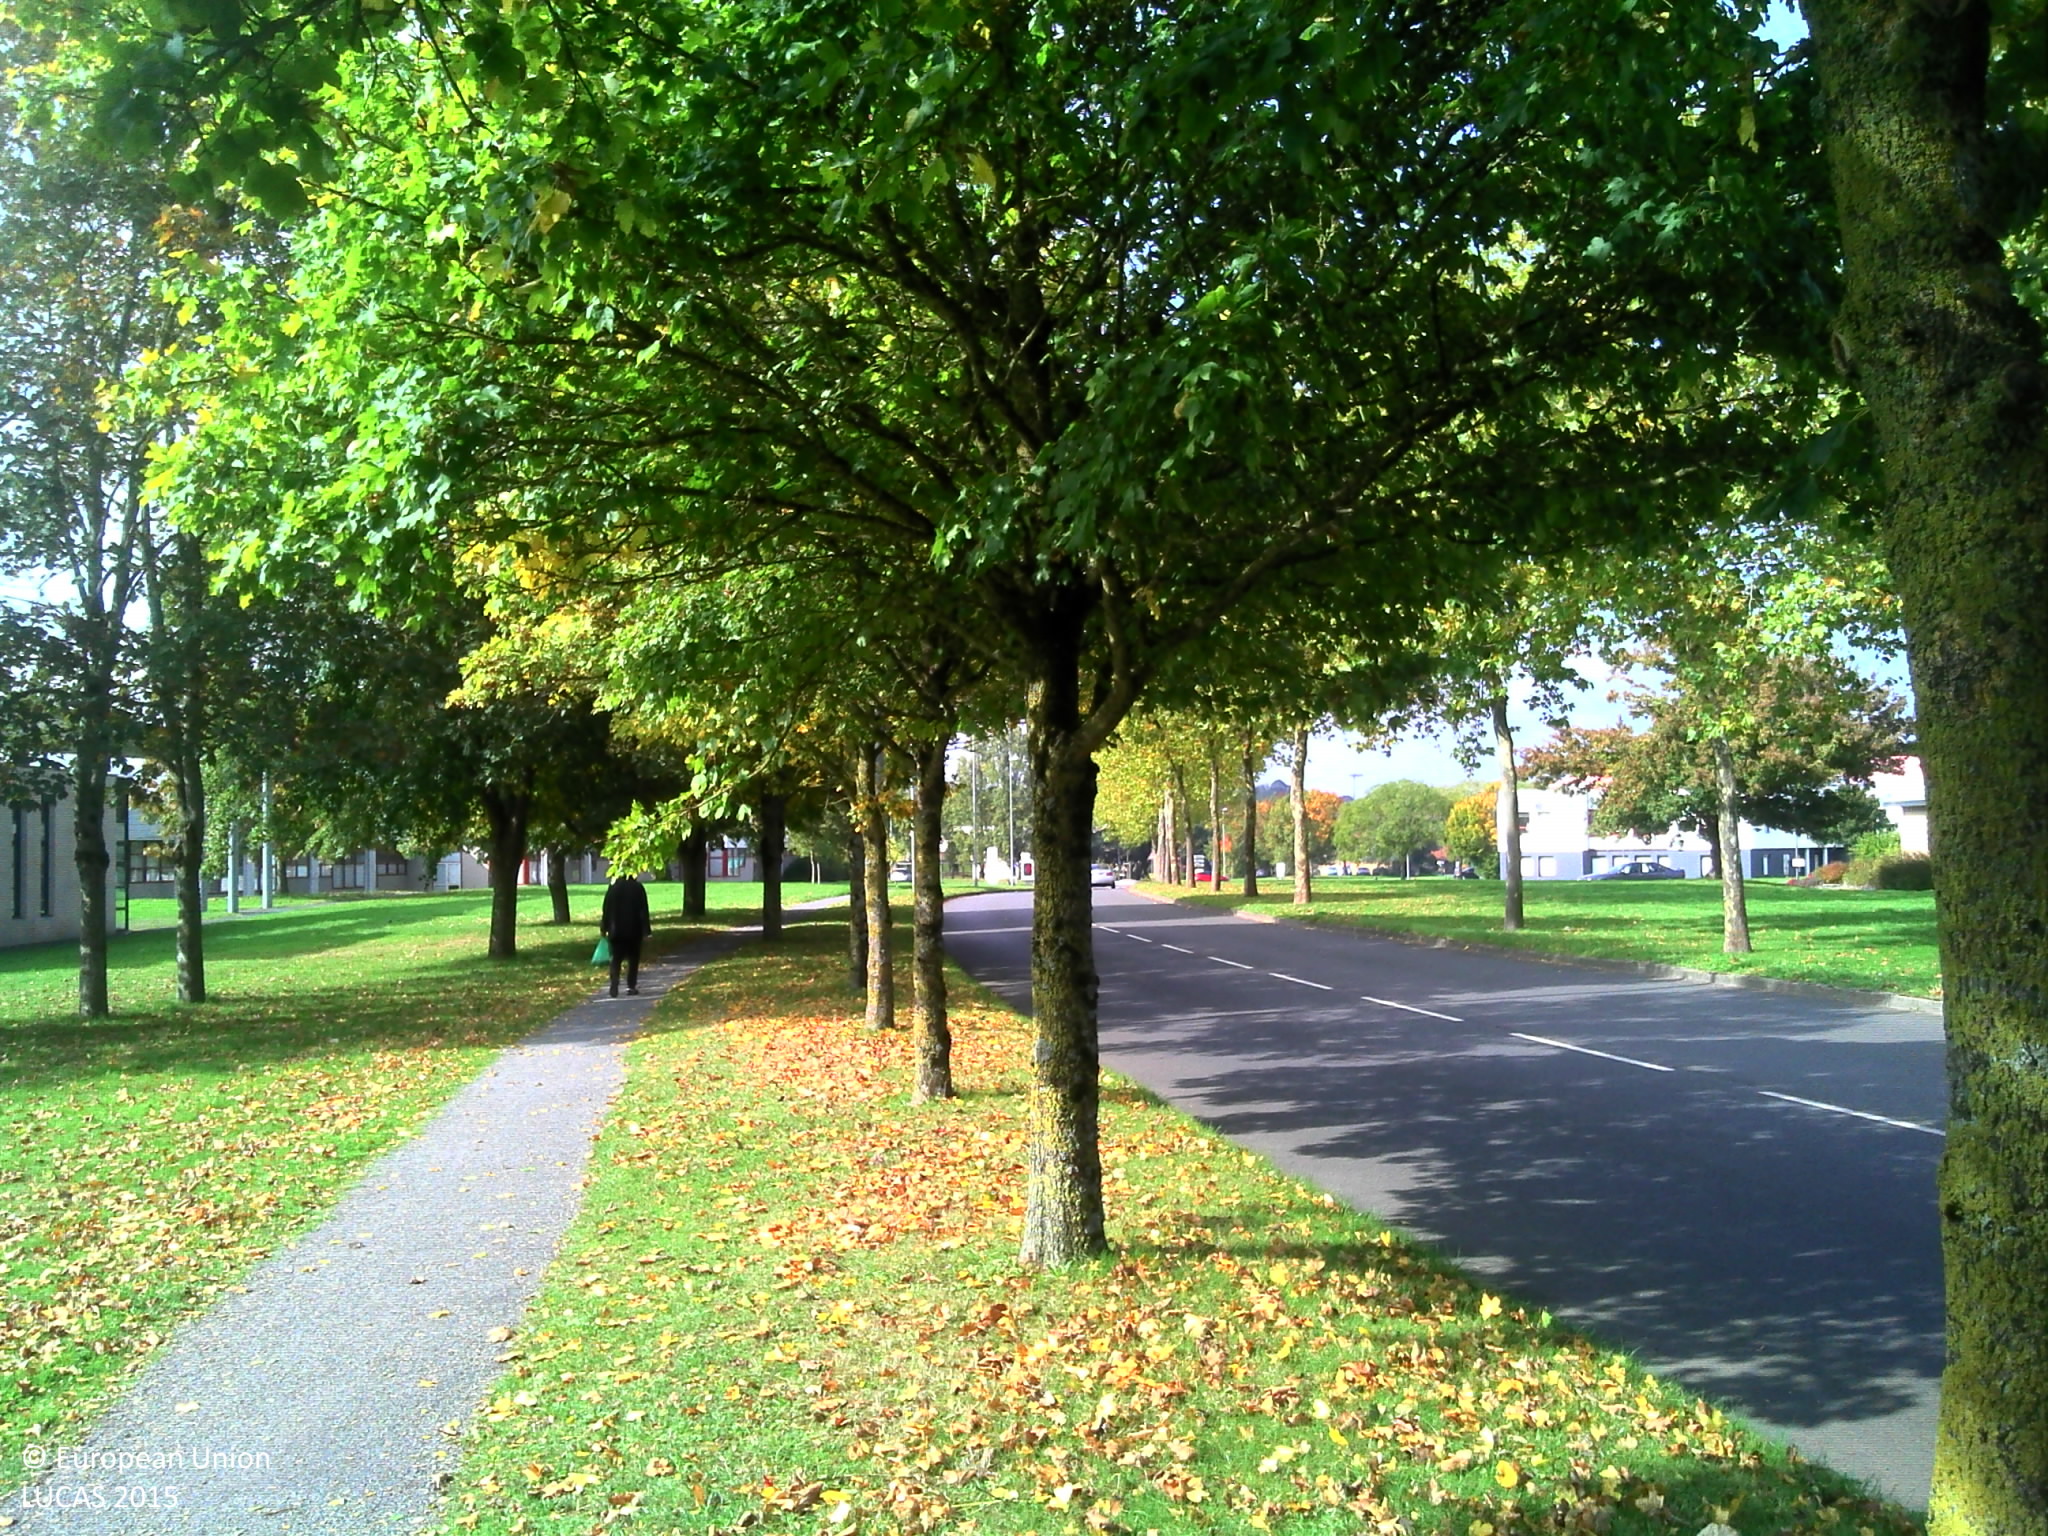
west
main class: Woodland
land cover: Broadleaved woodland
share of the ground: > 75 %
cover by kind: broadleaved forest trees 80 %, herbaceous plants 20 %
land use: Amenities, museums, leisure
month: October
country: FR
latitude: 47.0492
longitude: -0.8663
